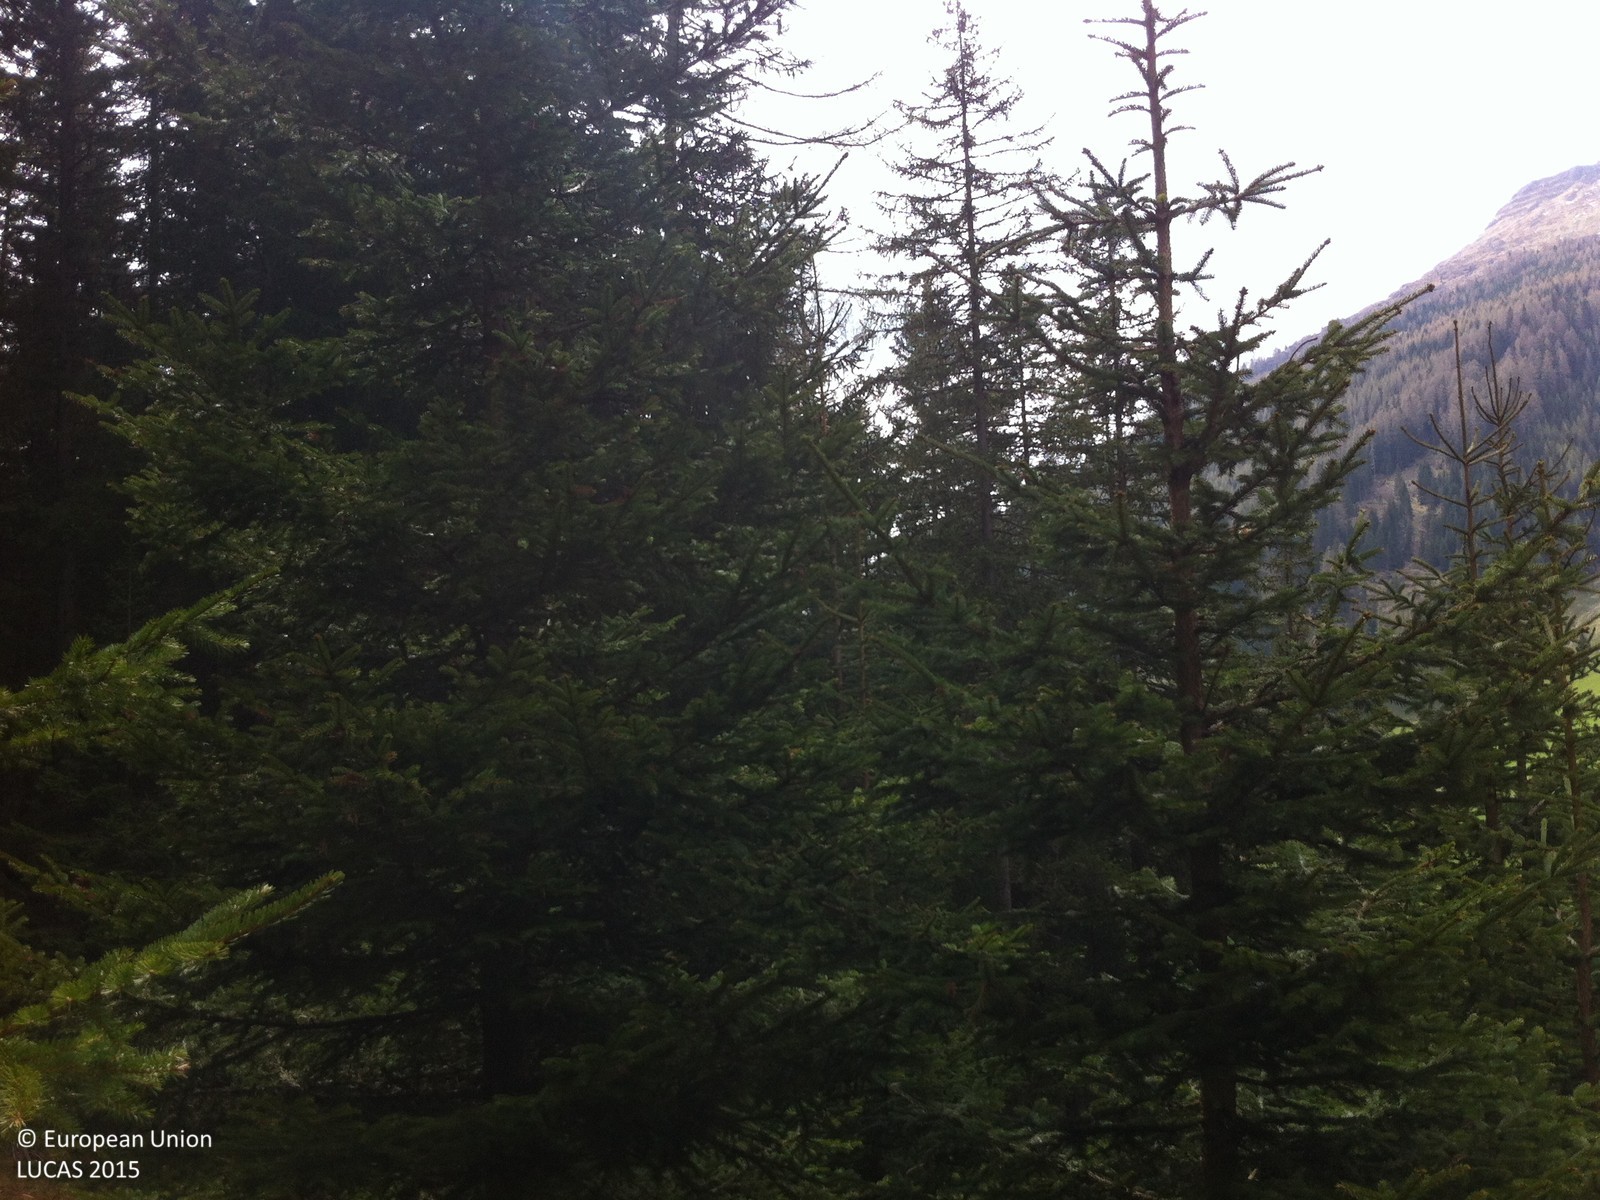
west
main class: Woodland
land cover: Spruce dominated coniferous woodland
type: alpine coniferous forest
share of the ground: 50 - 75 %
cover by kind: coniferous forest trees 55 %, herbaceous plants 25 %, lichens and mosses 20 %
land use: Forestry
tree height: < 5 m
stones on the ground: < 10 %
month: May
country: AT
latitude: 47.0782
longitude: 11.5658
